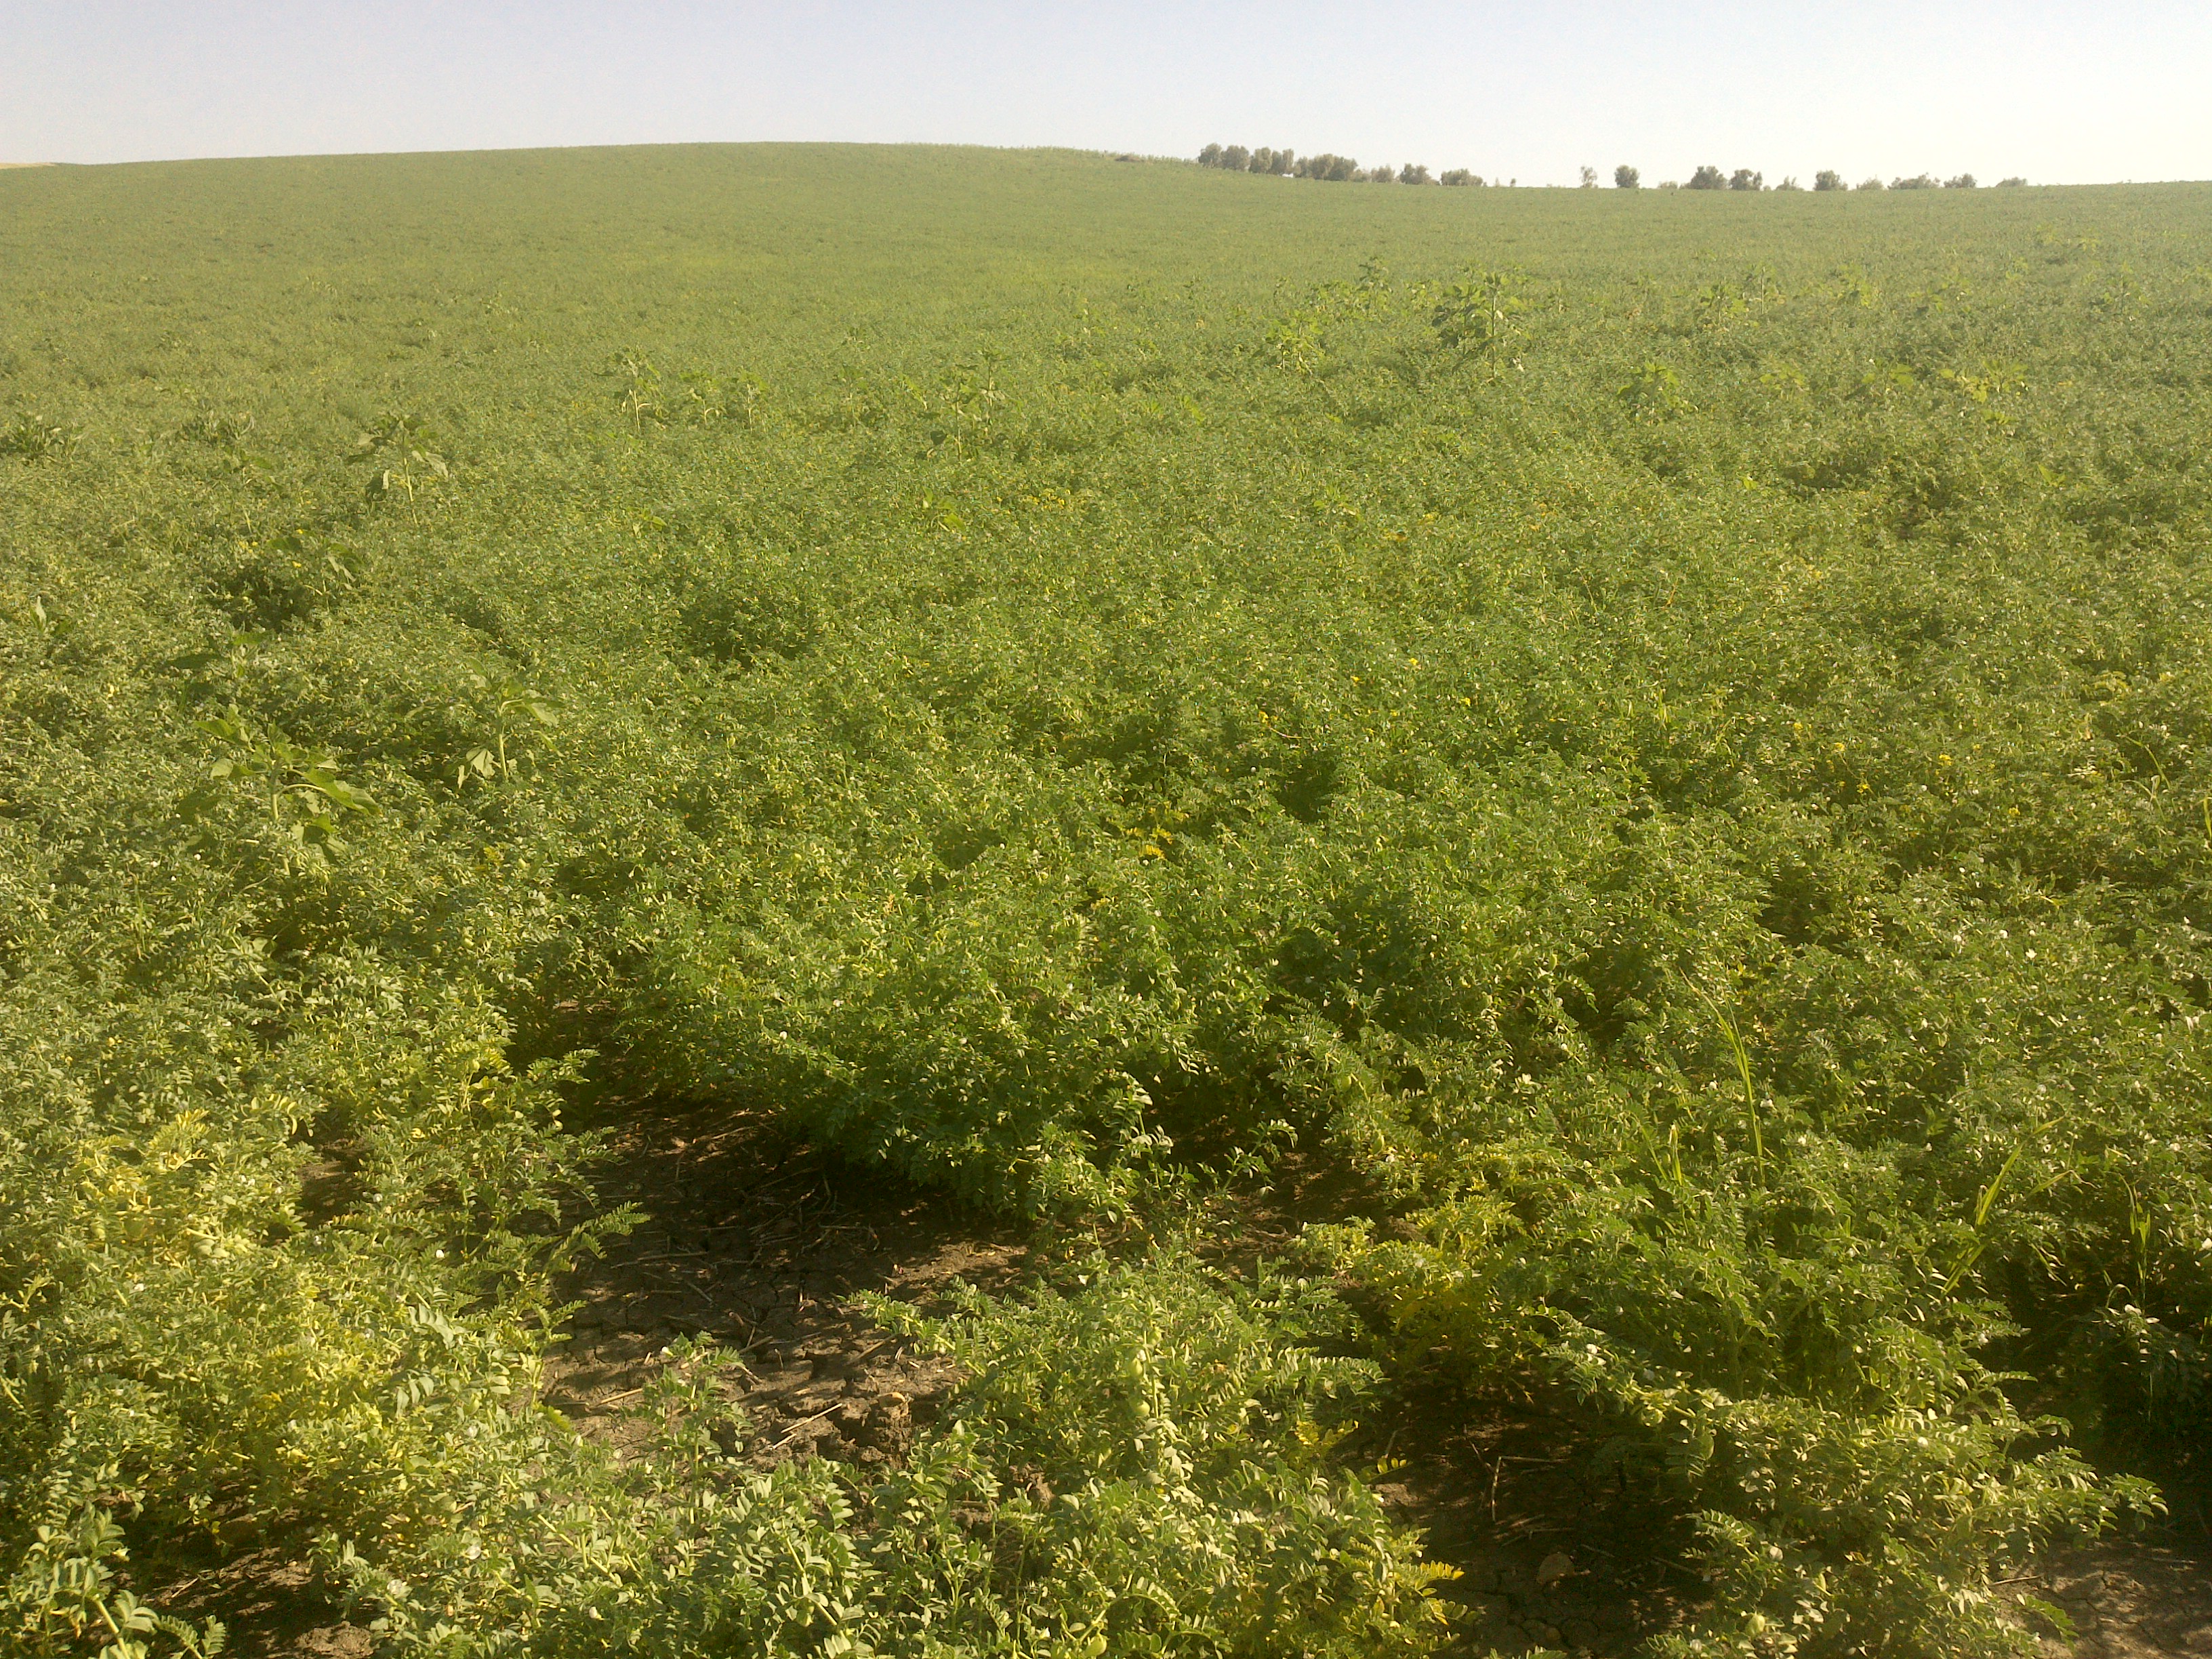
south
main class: Cropland
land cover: Dry pulses
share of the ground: > 75 %
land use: Agriculture (excluding fallow land and kitchen gardens)
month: May
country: ES
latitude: 37.9042
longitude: -4.5811
